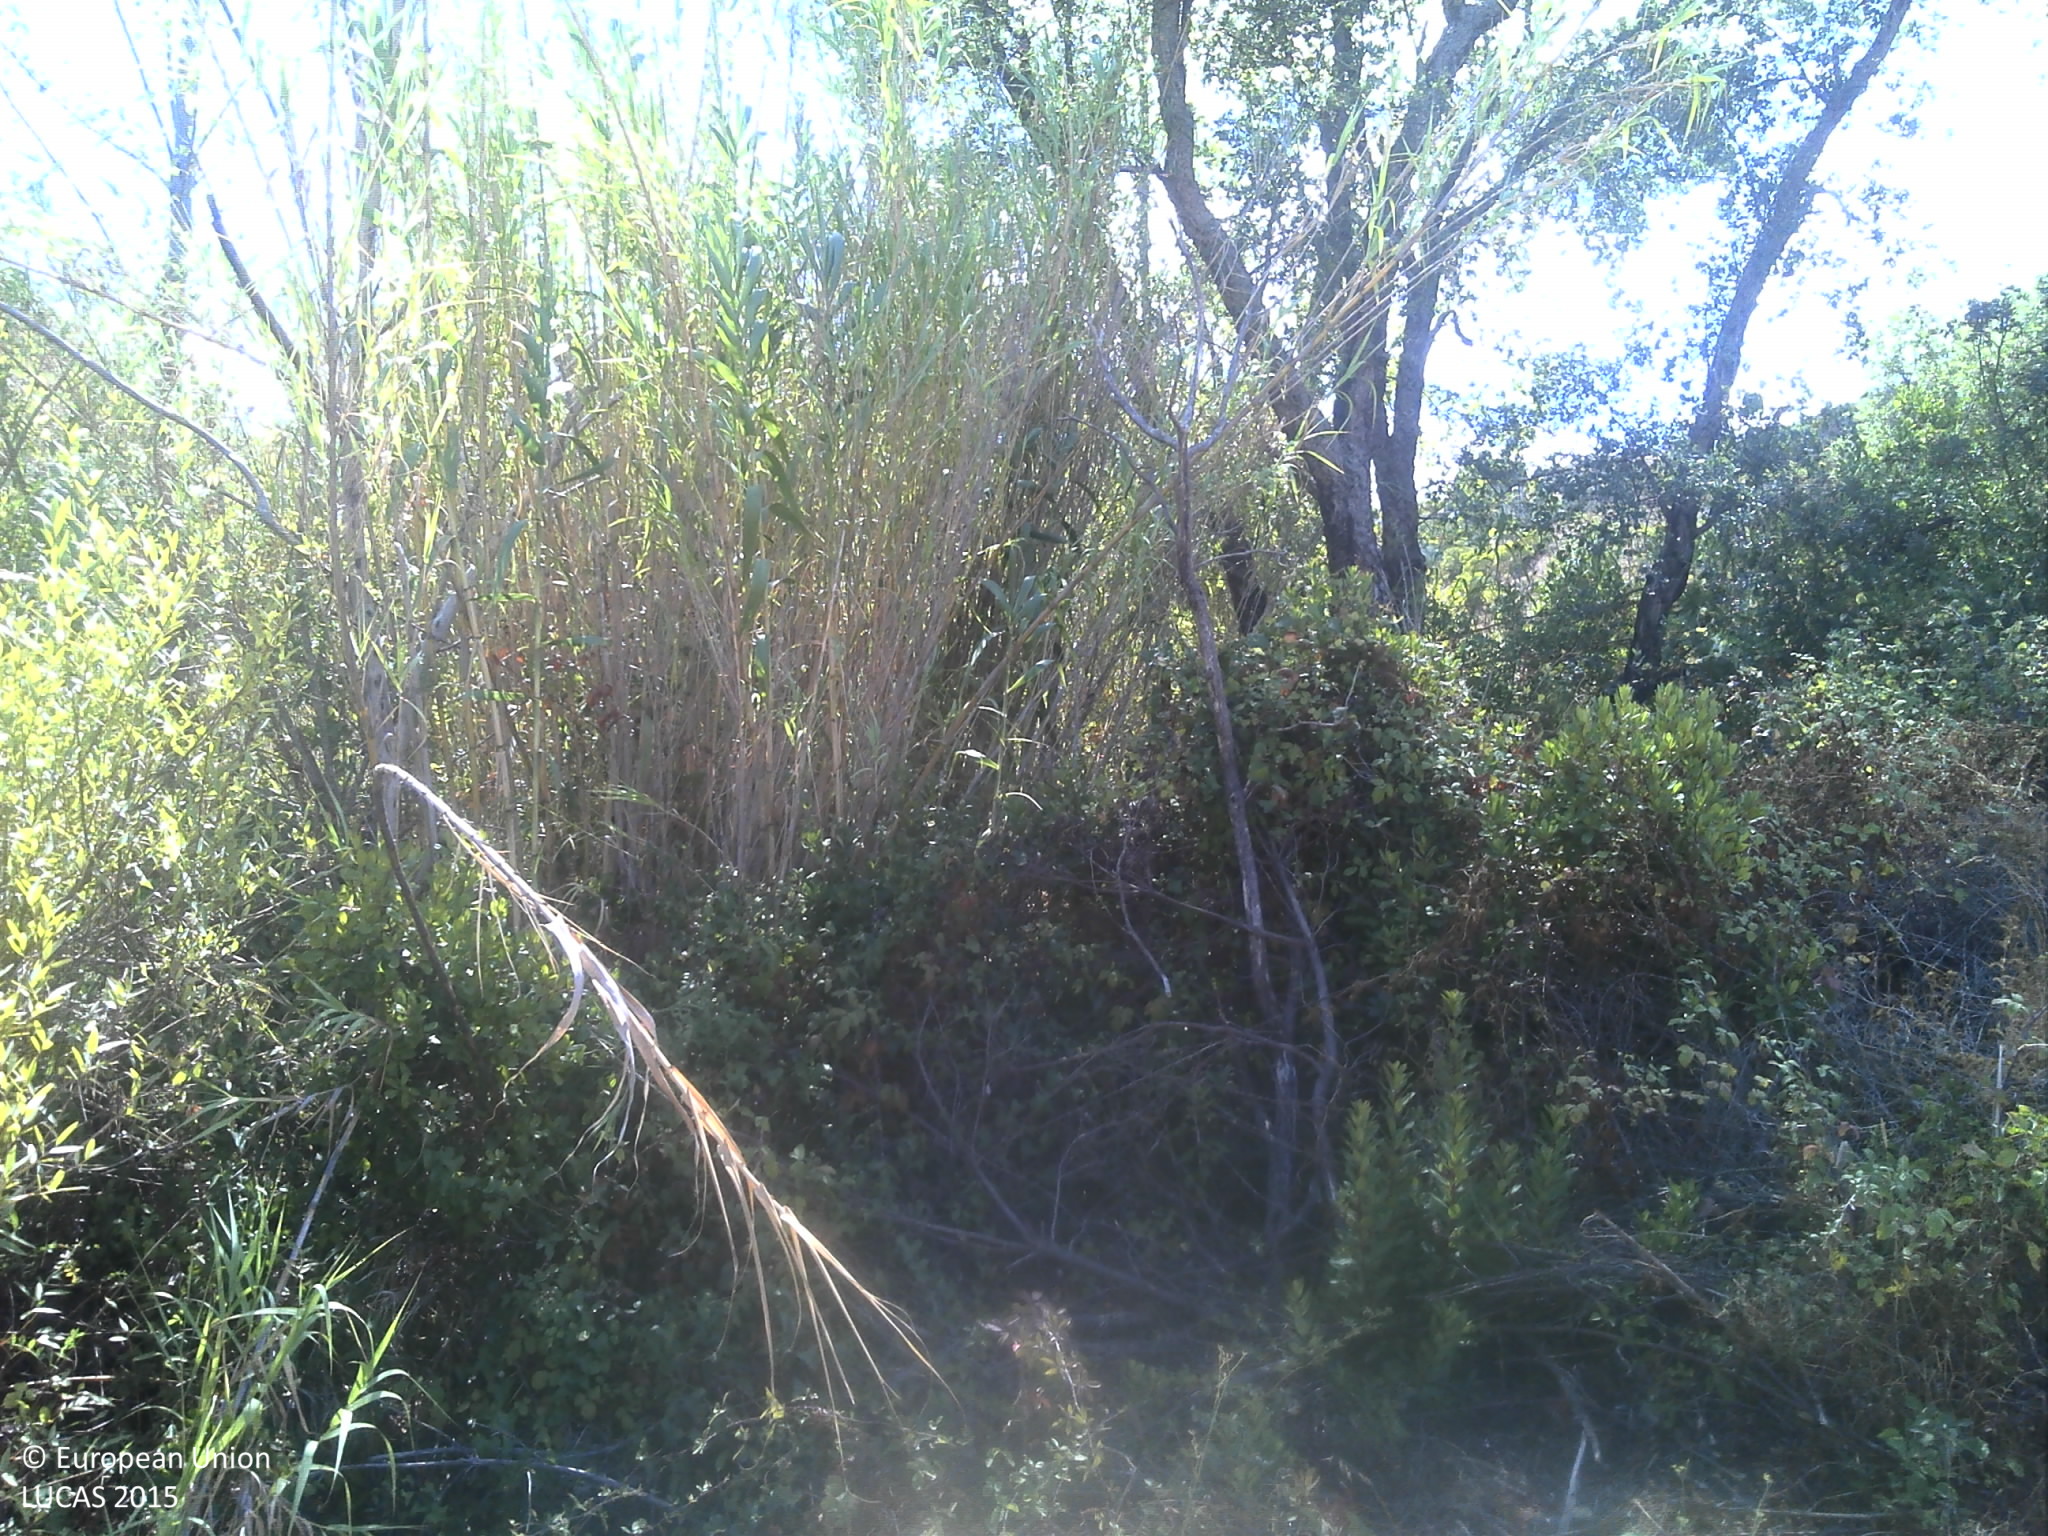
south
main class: Shrubland
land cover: Shrubland with sparse tree cover
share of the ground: > 75 %
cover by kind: shrubs 75 %, unconsolidated bare surface 20 %, broadleaved forest trees 5 %
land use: Abandoned areas
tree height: < 5 m
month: September
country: PT
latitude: 37.3093
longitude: -8.1977
